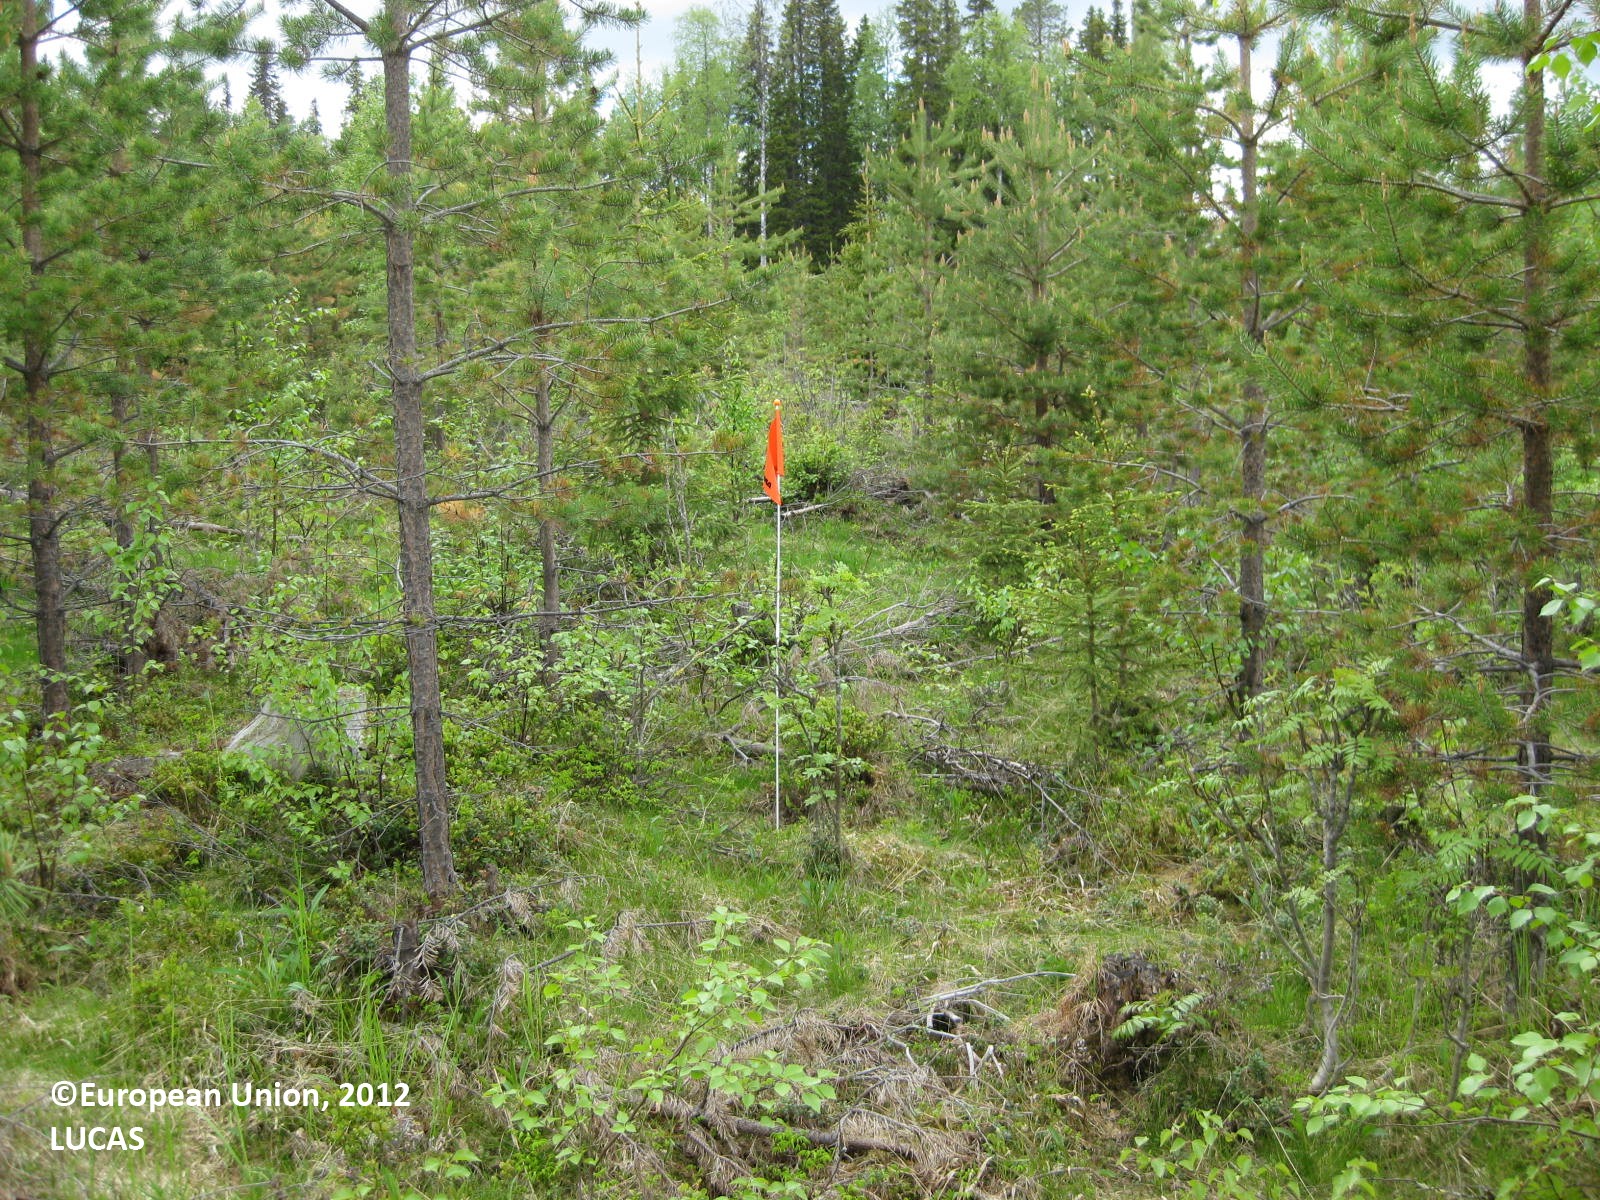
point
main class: Woodland
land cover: Pine dominated mixed woodland
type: boreal forest
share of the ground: 50 - 75 %
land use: Forestry
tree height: < 5 m
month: June
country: FI
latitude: 65.2240
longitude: 28.9366
